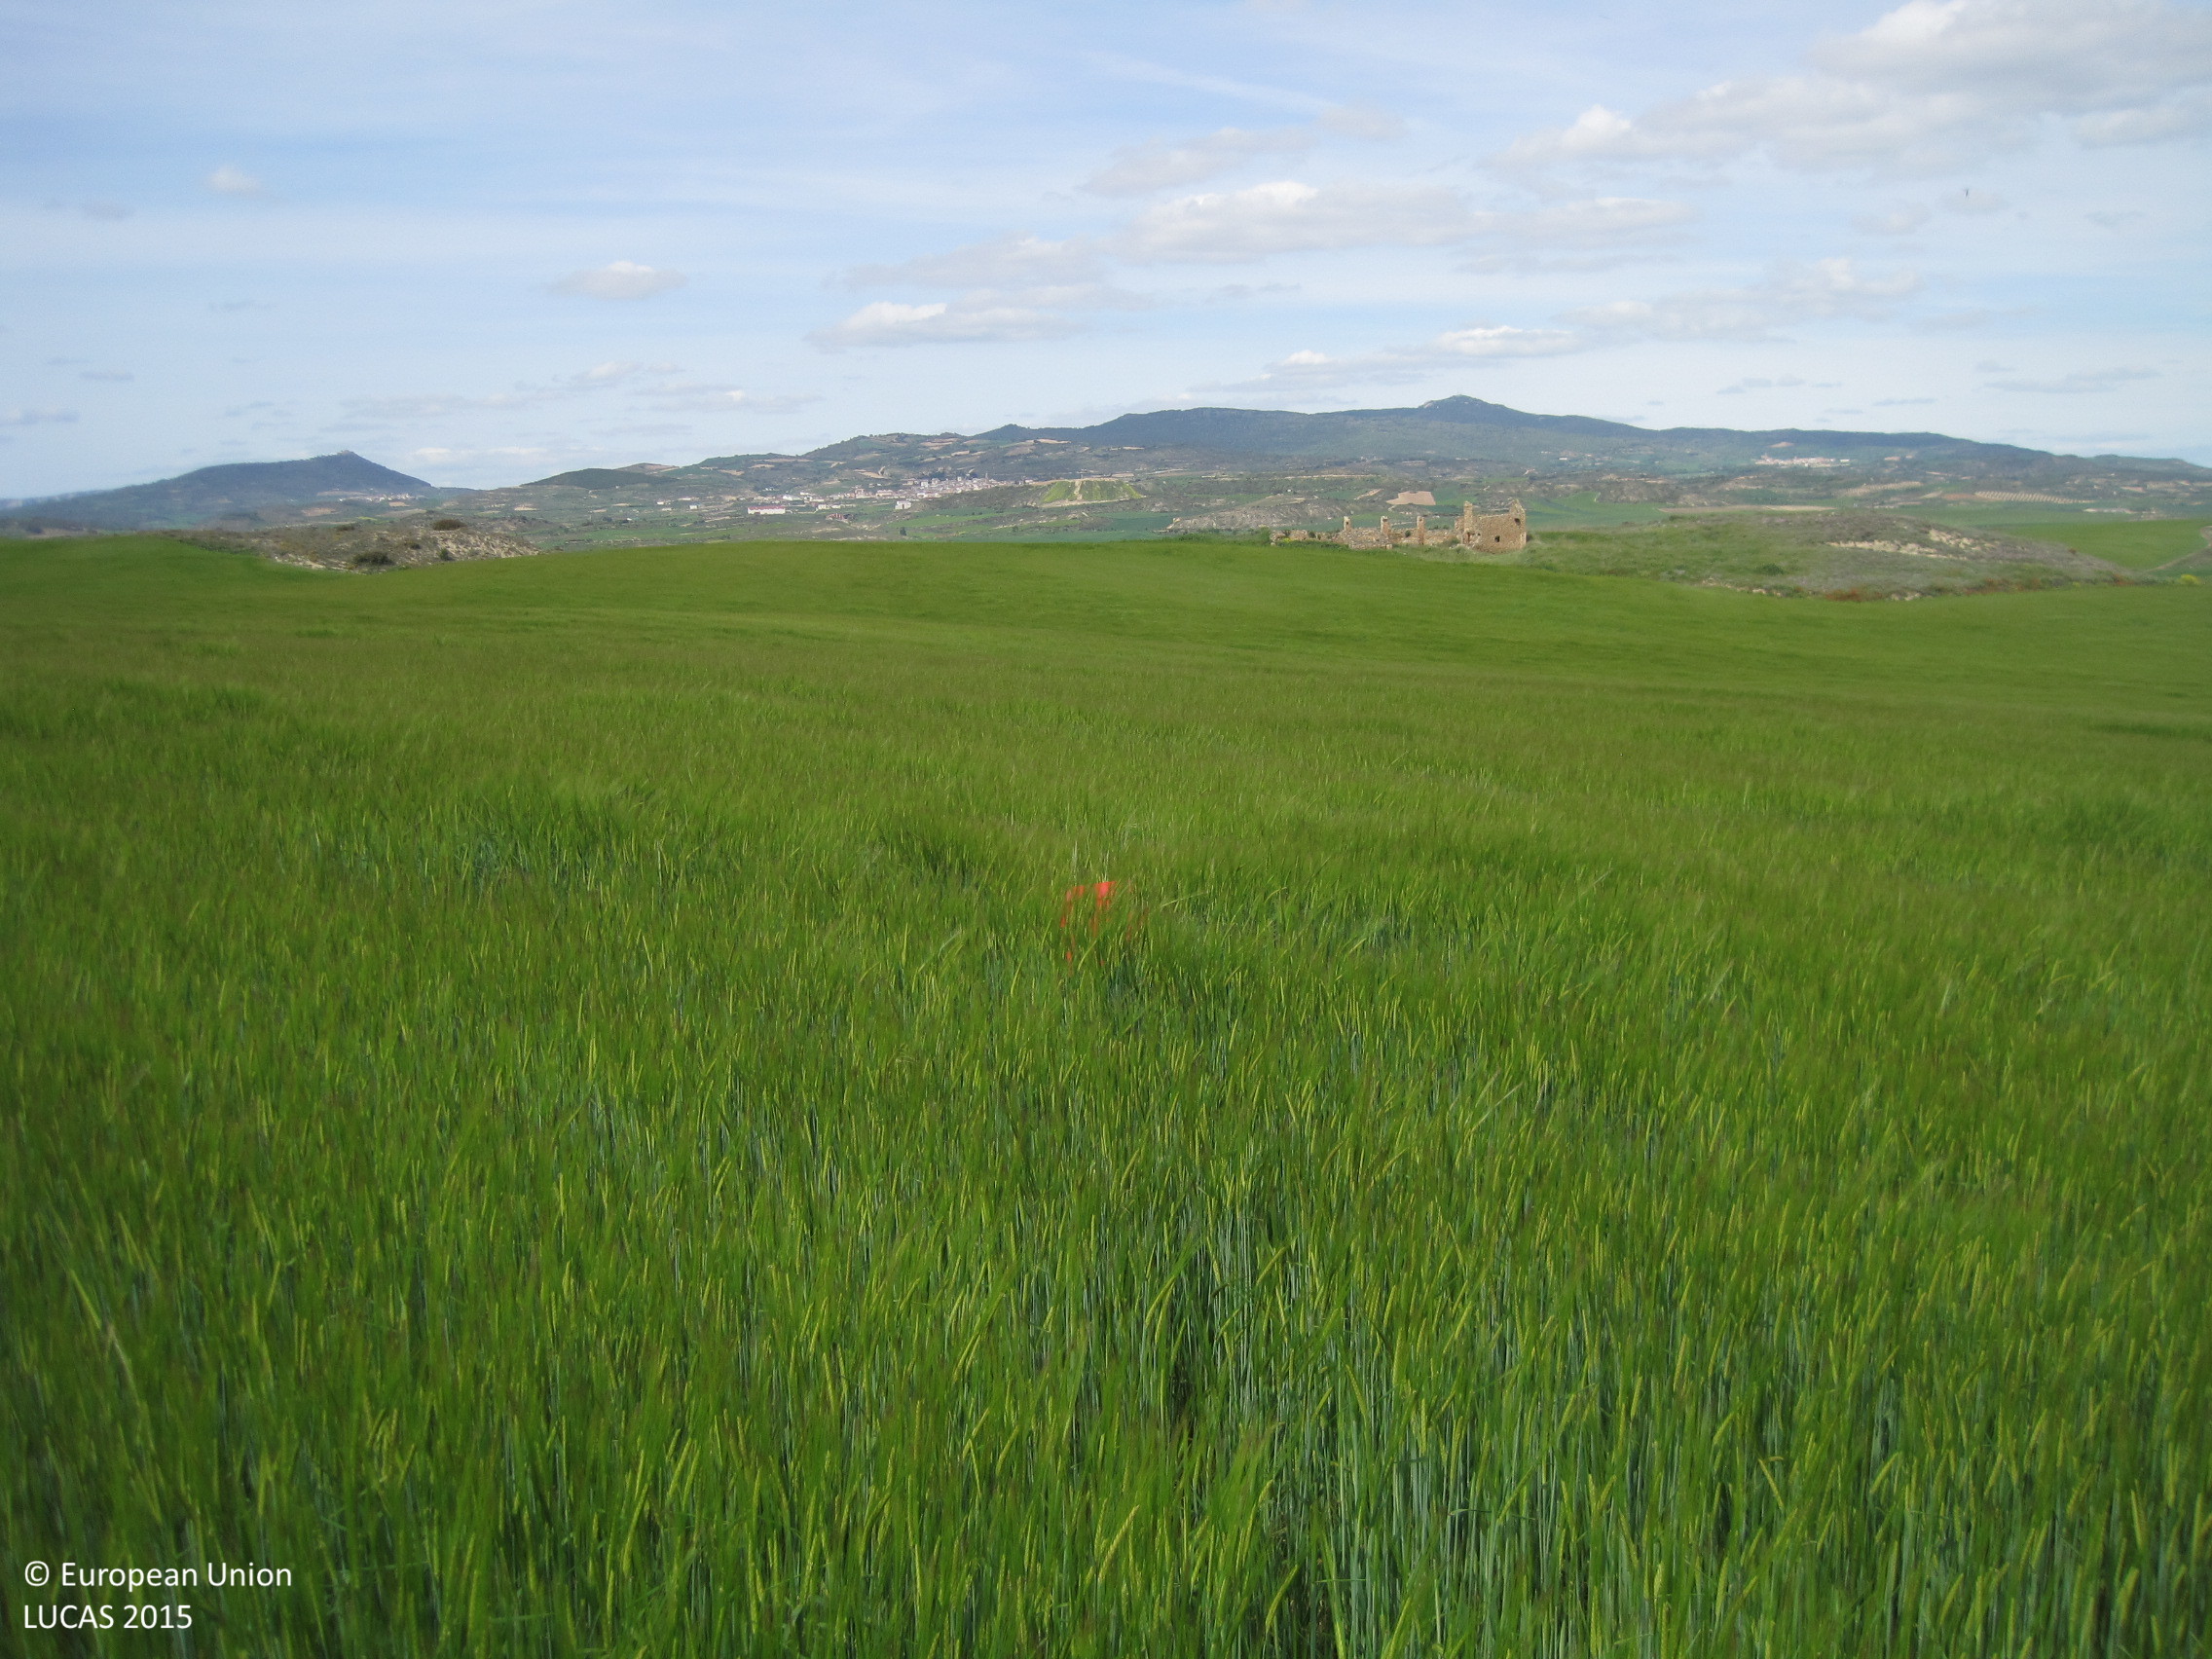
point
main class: Cropland
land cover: Barley
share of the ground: > 75 %
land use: Agriculture (excluding fallow land and kitchen gardens)
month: April
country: ES
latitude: 42.5448
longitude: -2.1093
